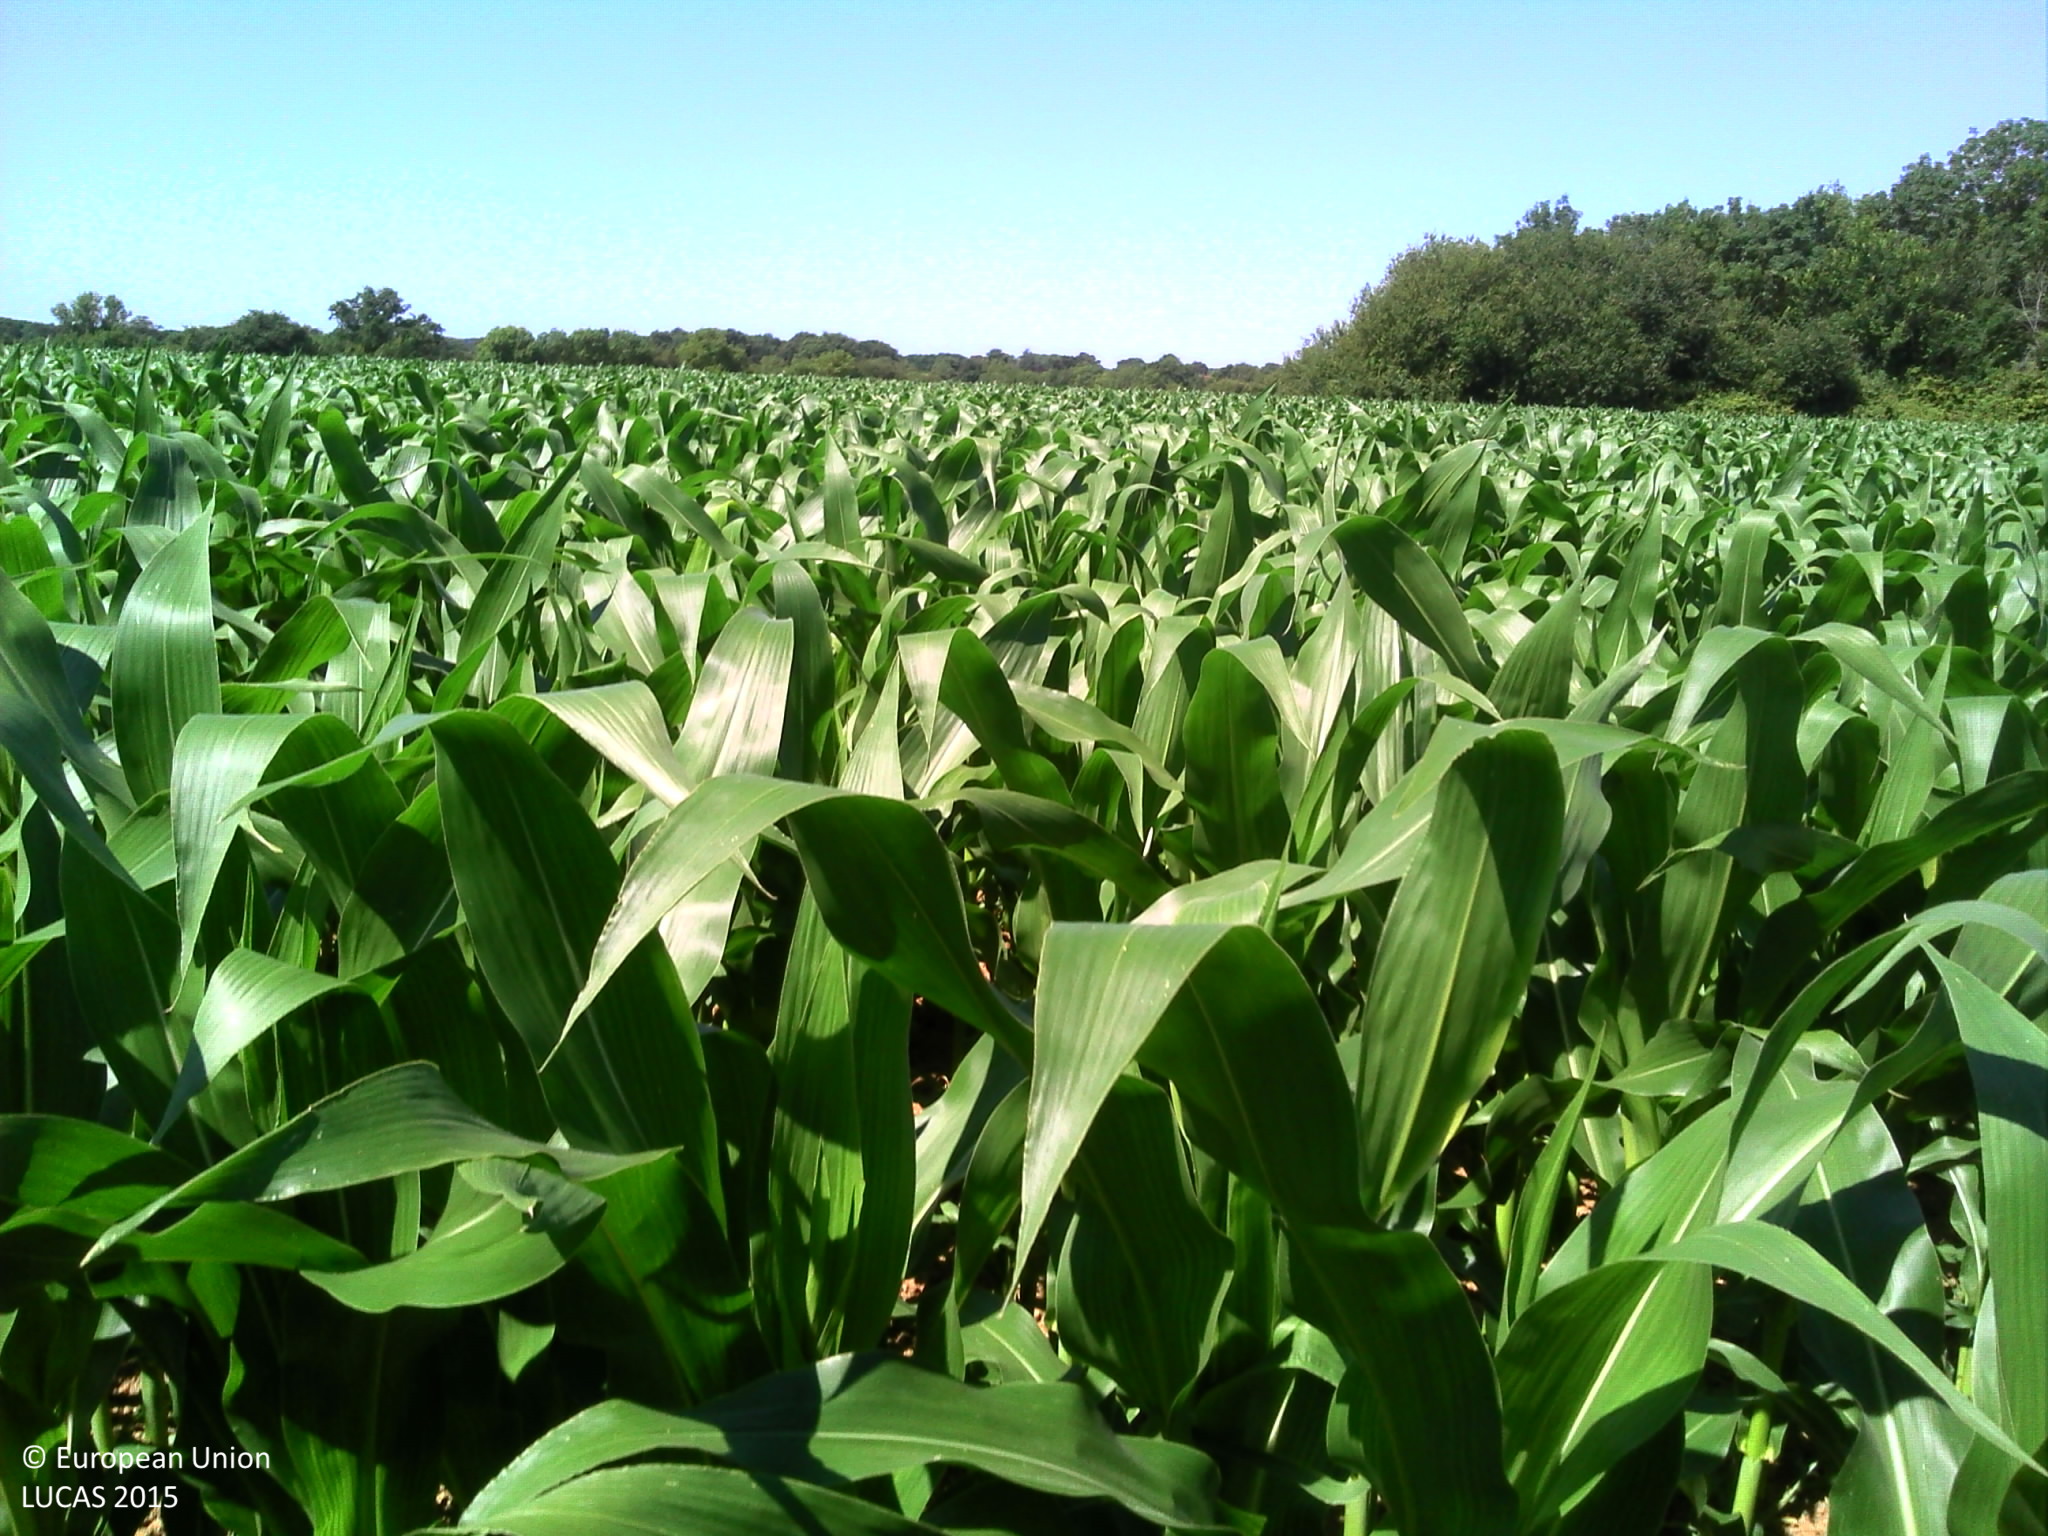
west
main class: Cropland
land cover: Maize
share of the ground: > 75 %
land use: Agriculture (excluding fallow land and kitchen gardens)
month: July
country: FR
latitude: 47.1776
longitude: -1.7216
